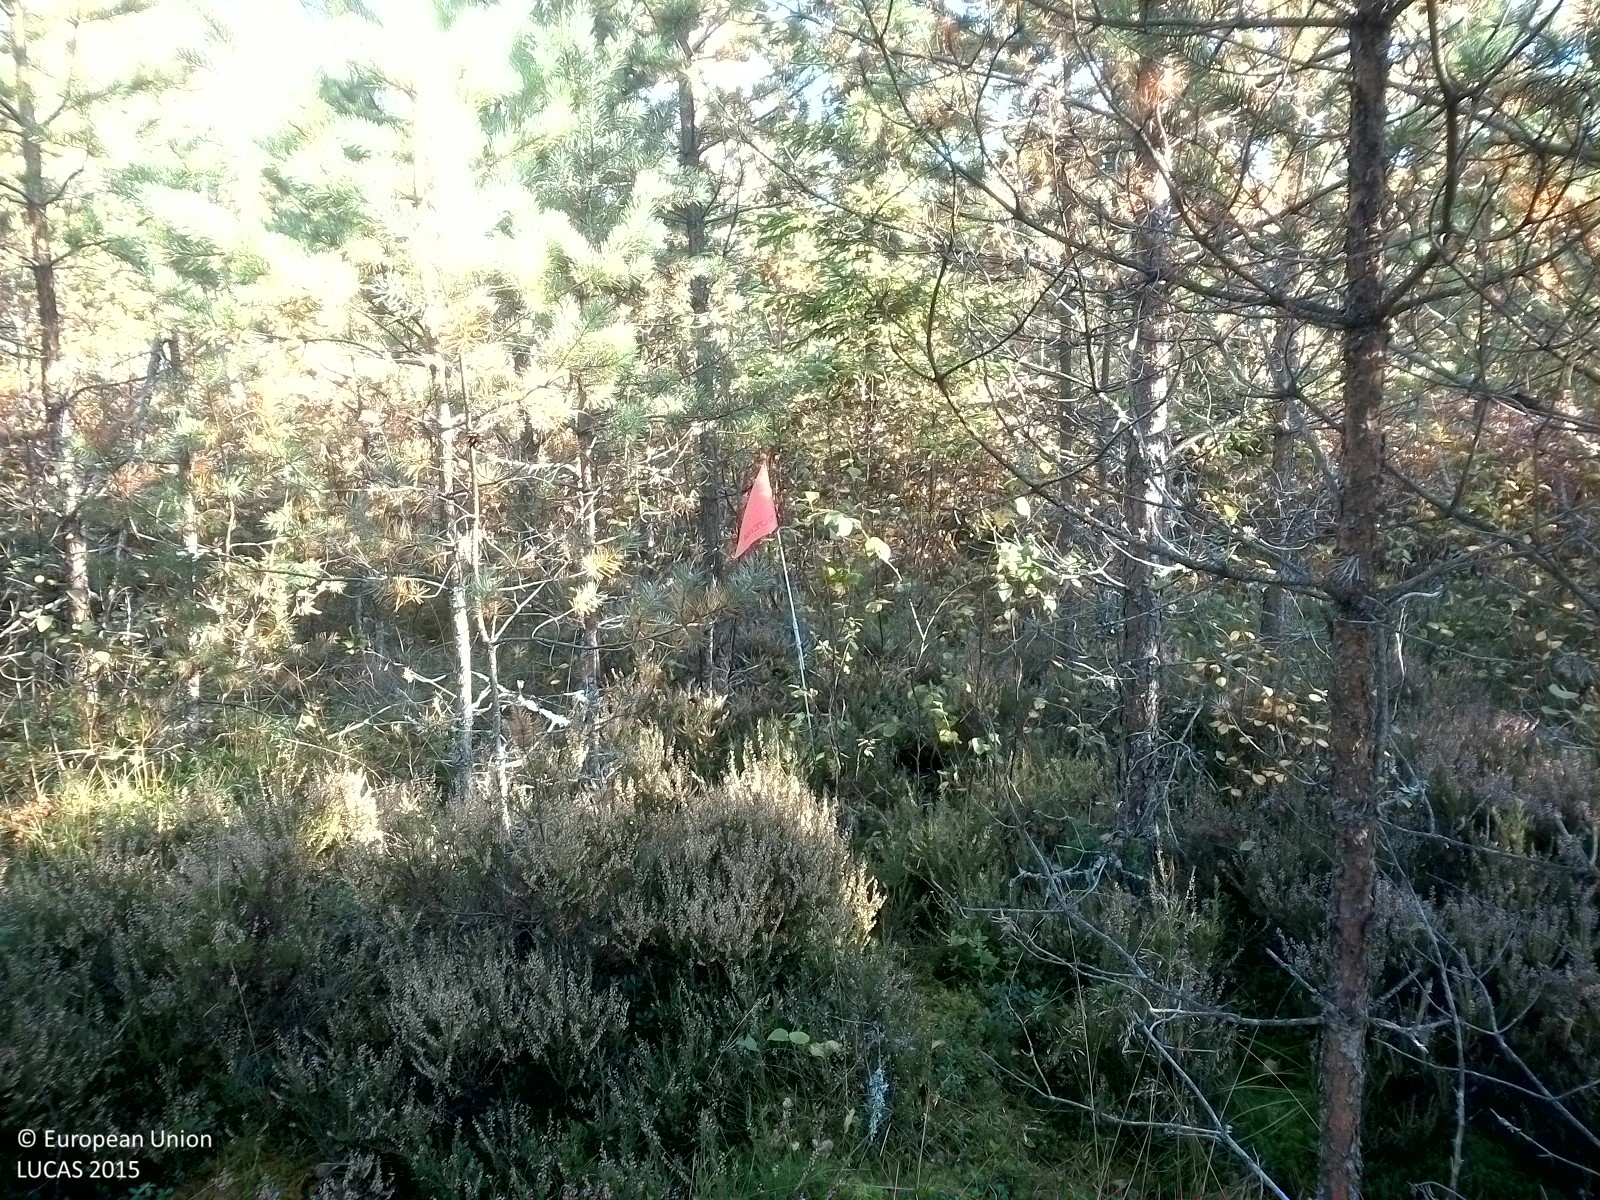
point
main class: Woodland
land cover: Pine dominated coniferous woodland
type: boreal forest
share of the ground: 50 - 75 %
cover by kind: coniferous forest trees 55 %, herbaceous plants 20 %, shrubs 15 %, broadleaved forest trees 5 %, lichens and mosses 5 %
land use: Forestry
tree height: < 5 m
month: September
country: SE
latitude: 58.7904
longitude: 15.5474
